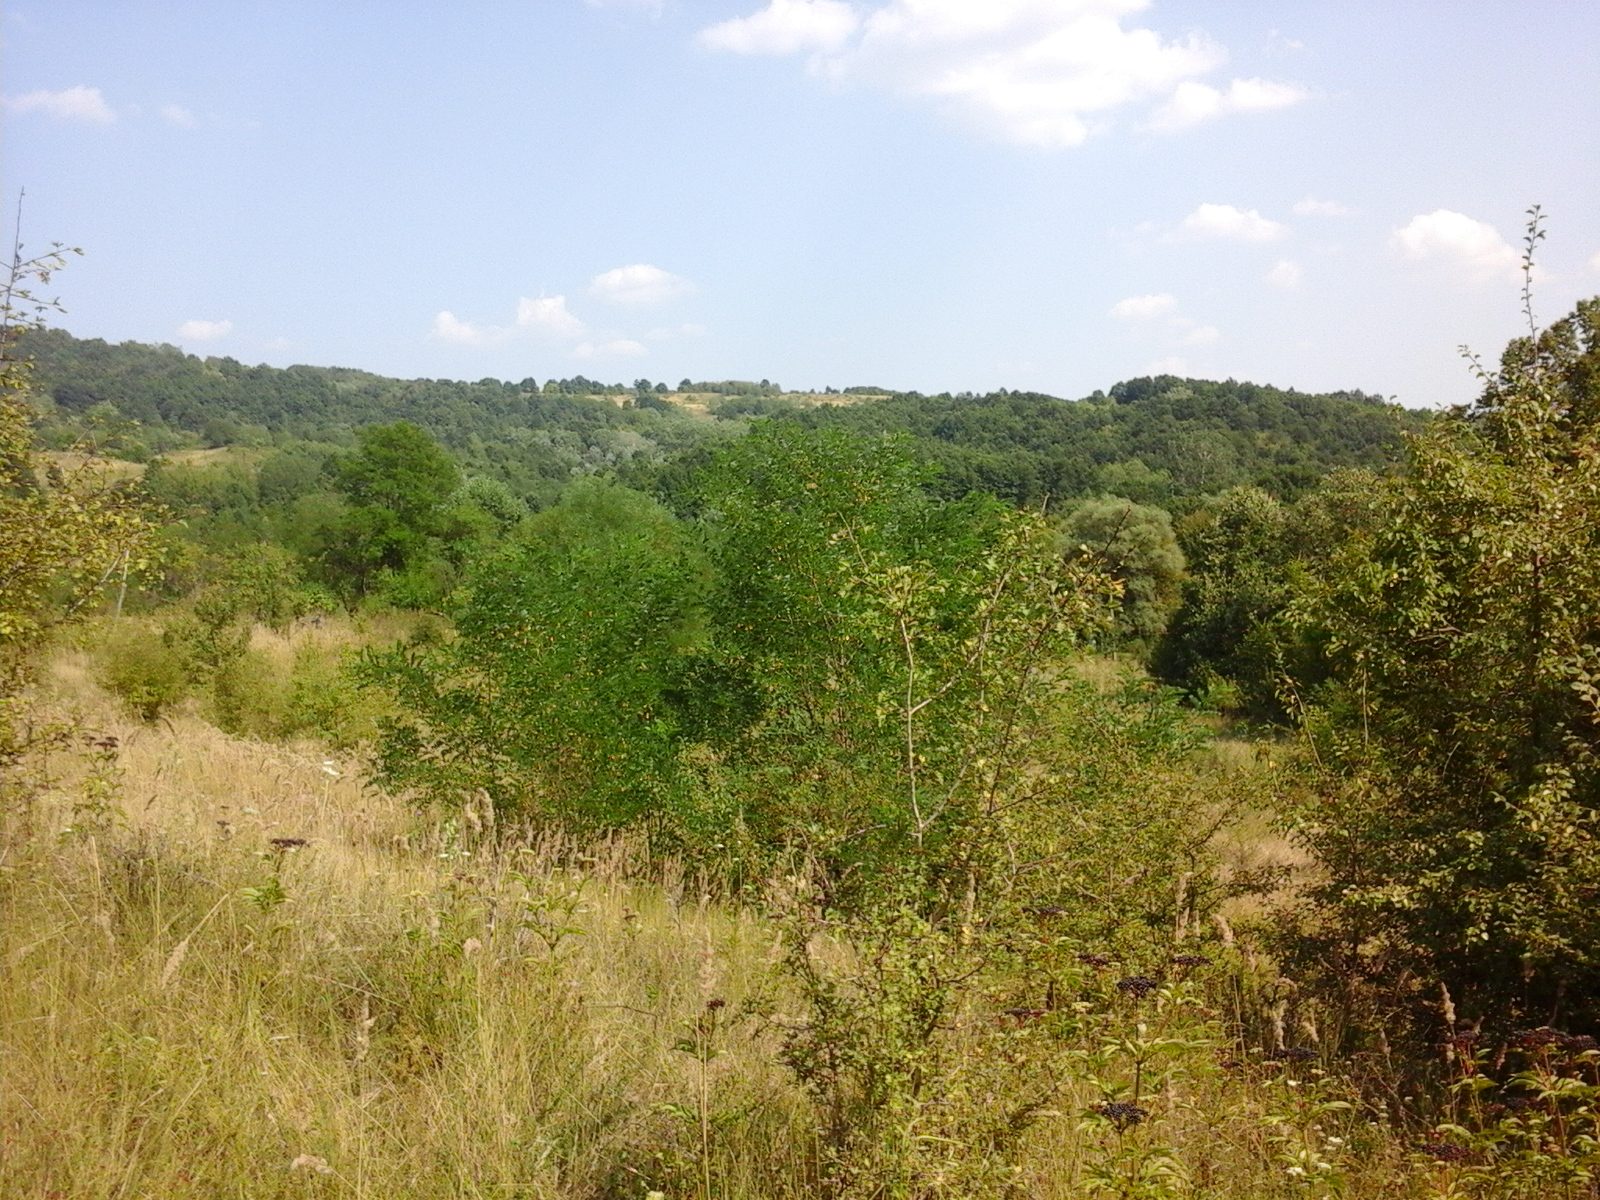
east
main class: Grassland
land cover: Grassland with sparse tree/shrub cover
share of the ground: > 75 %
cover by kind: herbaceous plants 95 %, broadleaved forest trees 5 %
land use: Agriculture (excluding fallow land and kitchen gardens)
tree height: < 5 m
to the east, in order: Grassland with sparse tree/shrub cover; Fences; Broadleaved woodland; Electric lines; Broadleaved woodland; Tracks; Grassland with sparse tree/shrub cover
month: August
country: RO
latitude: 44.8545
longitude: 23.8936
